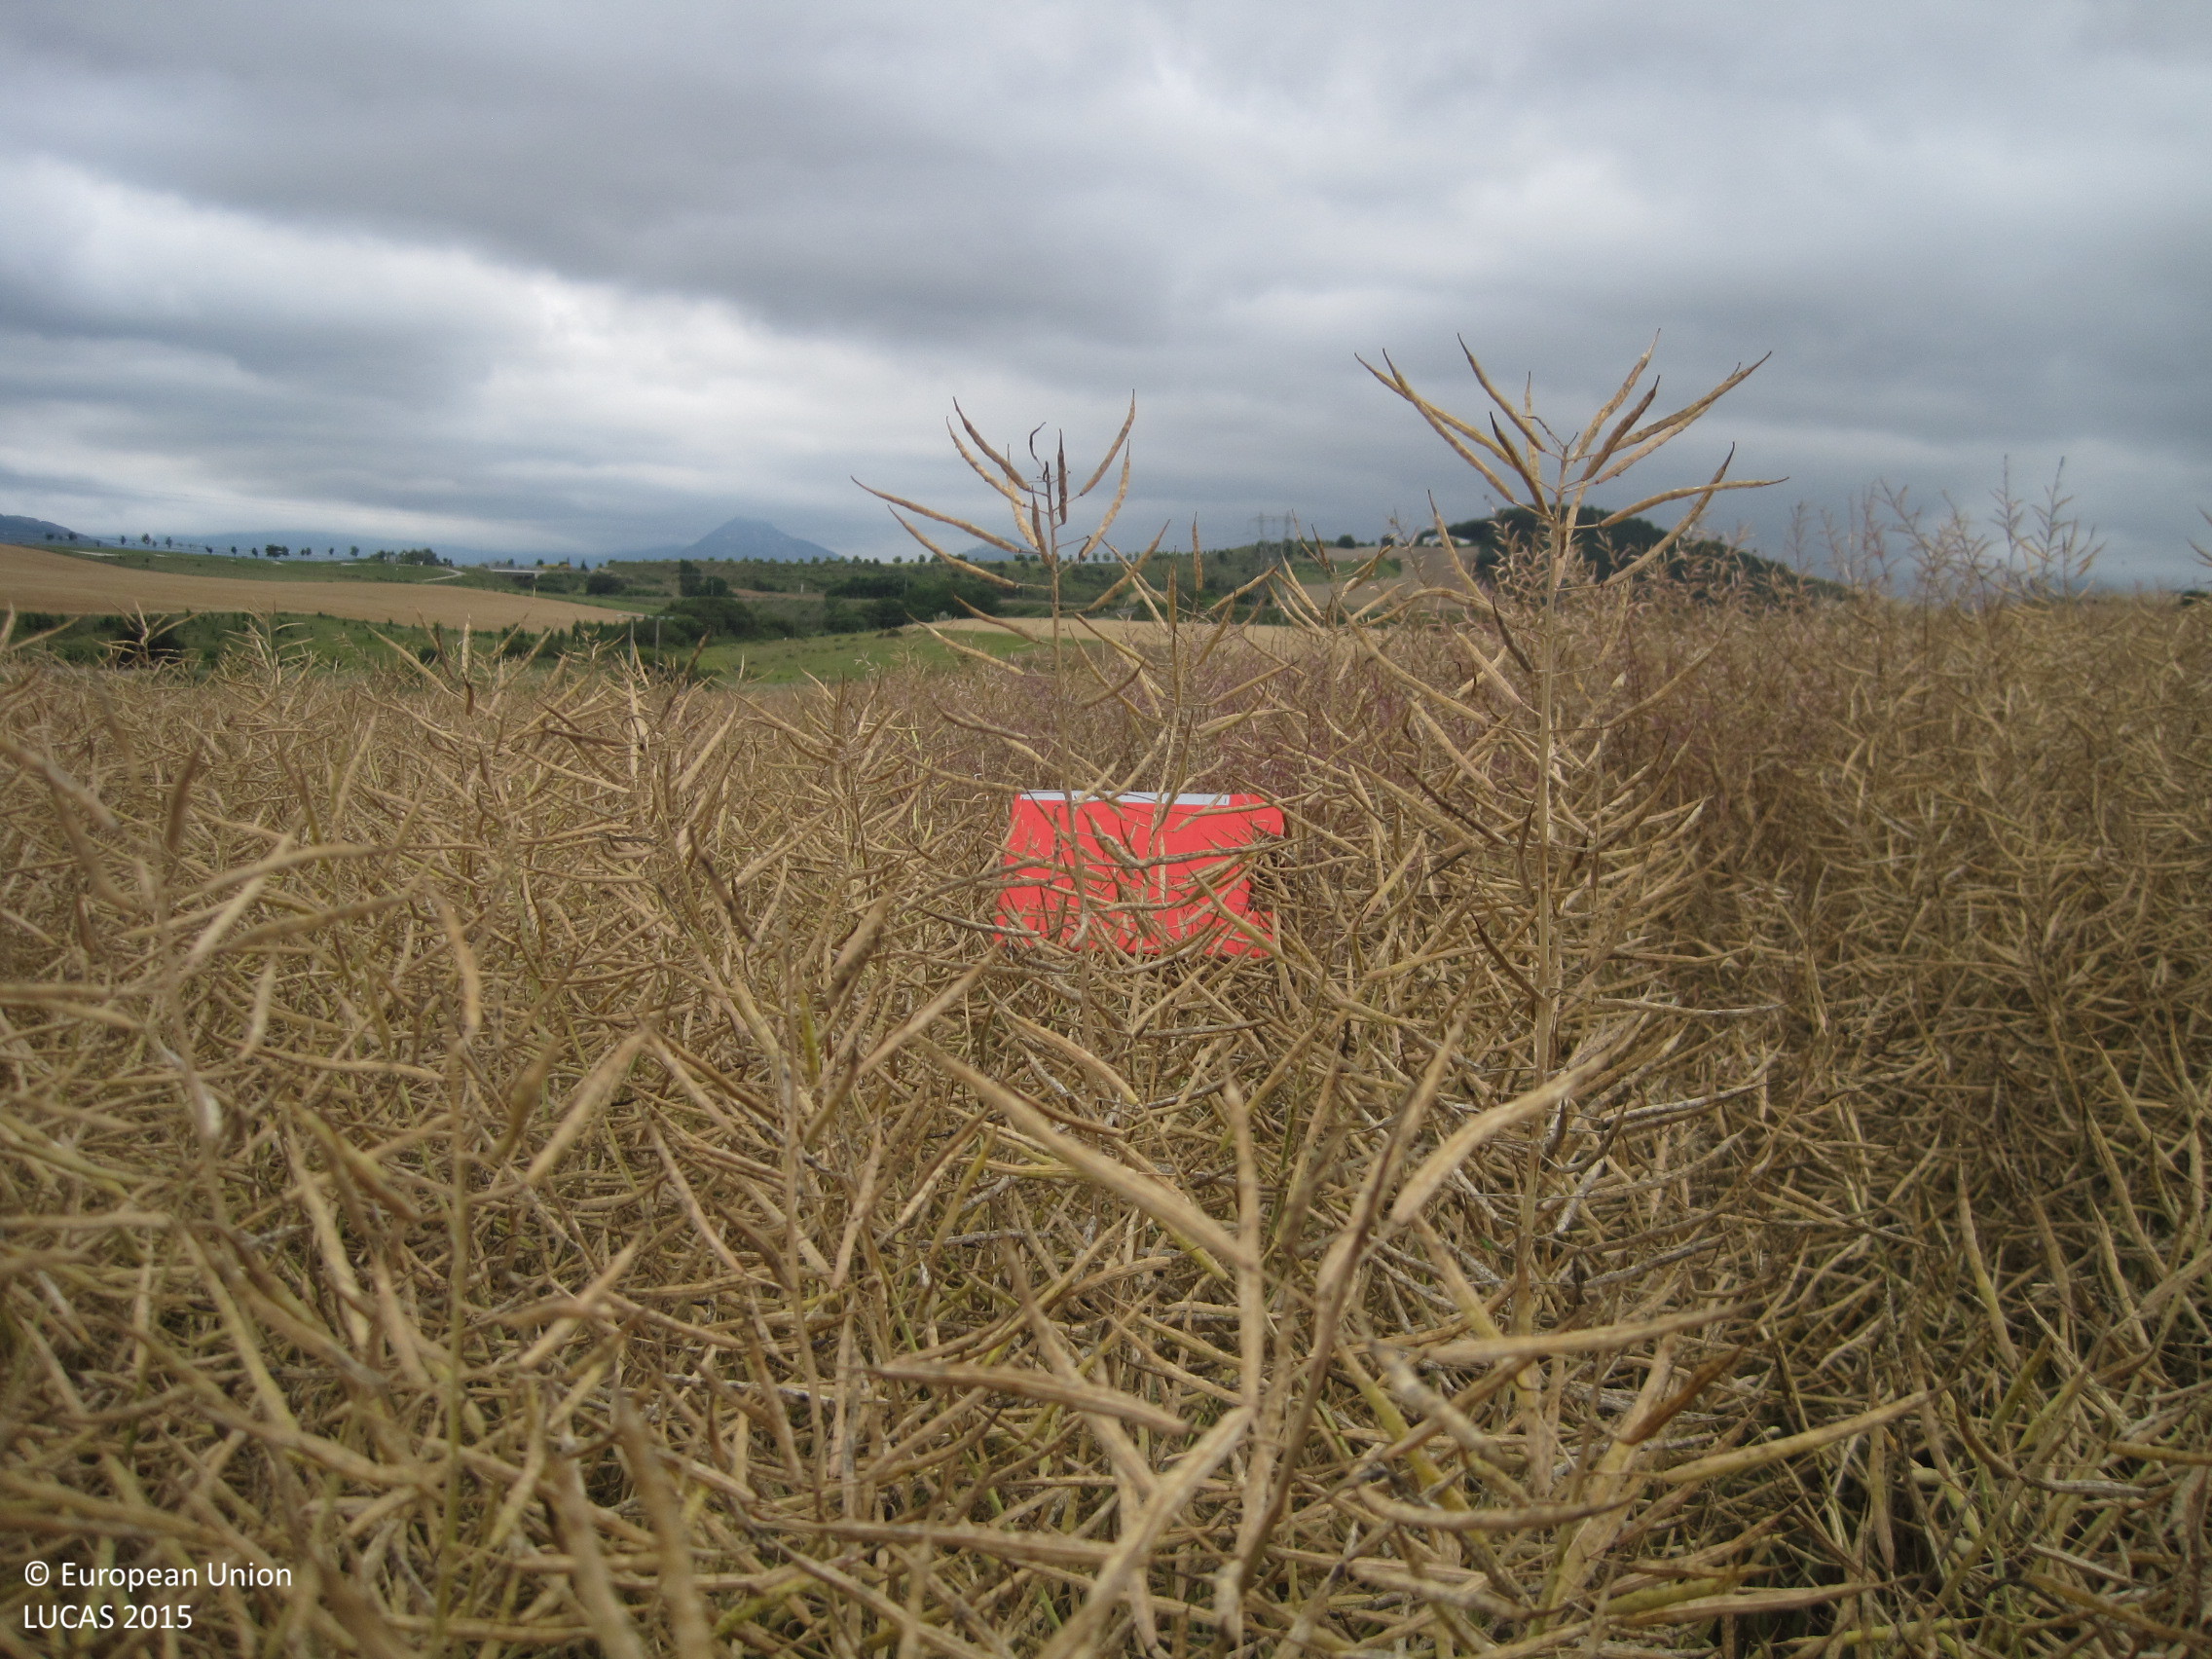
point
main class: Cropland
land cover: Rape and turnip rape
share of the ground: > 75 %
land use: Agriculture (excluding fallow land and kitchen gardens)
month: June
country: ES
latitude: 42.8454
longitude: -1.7257
